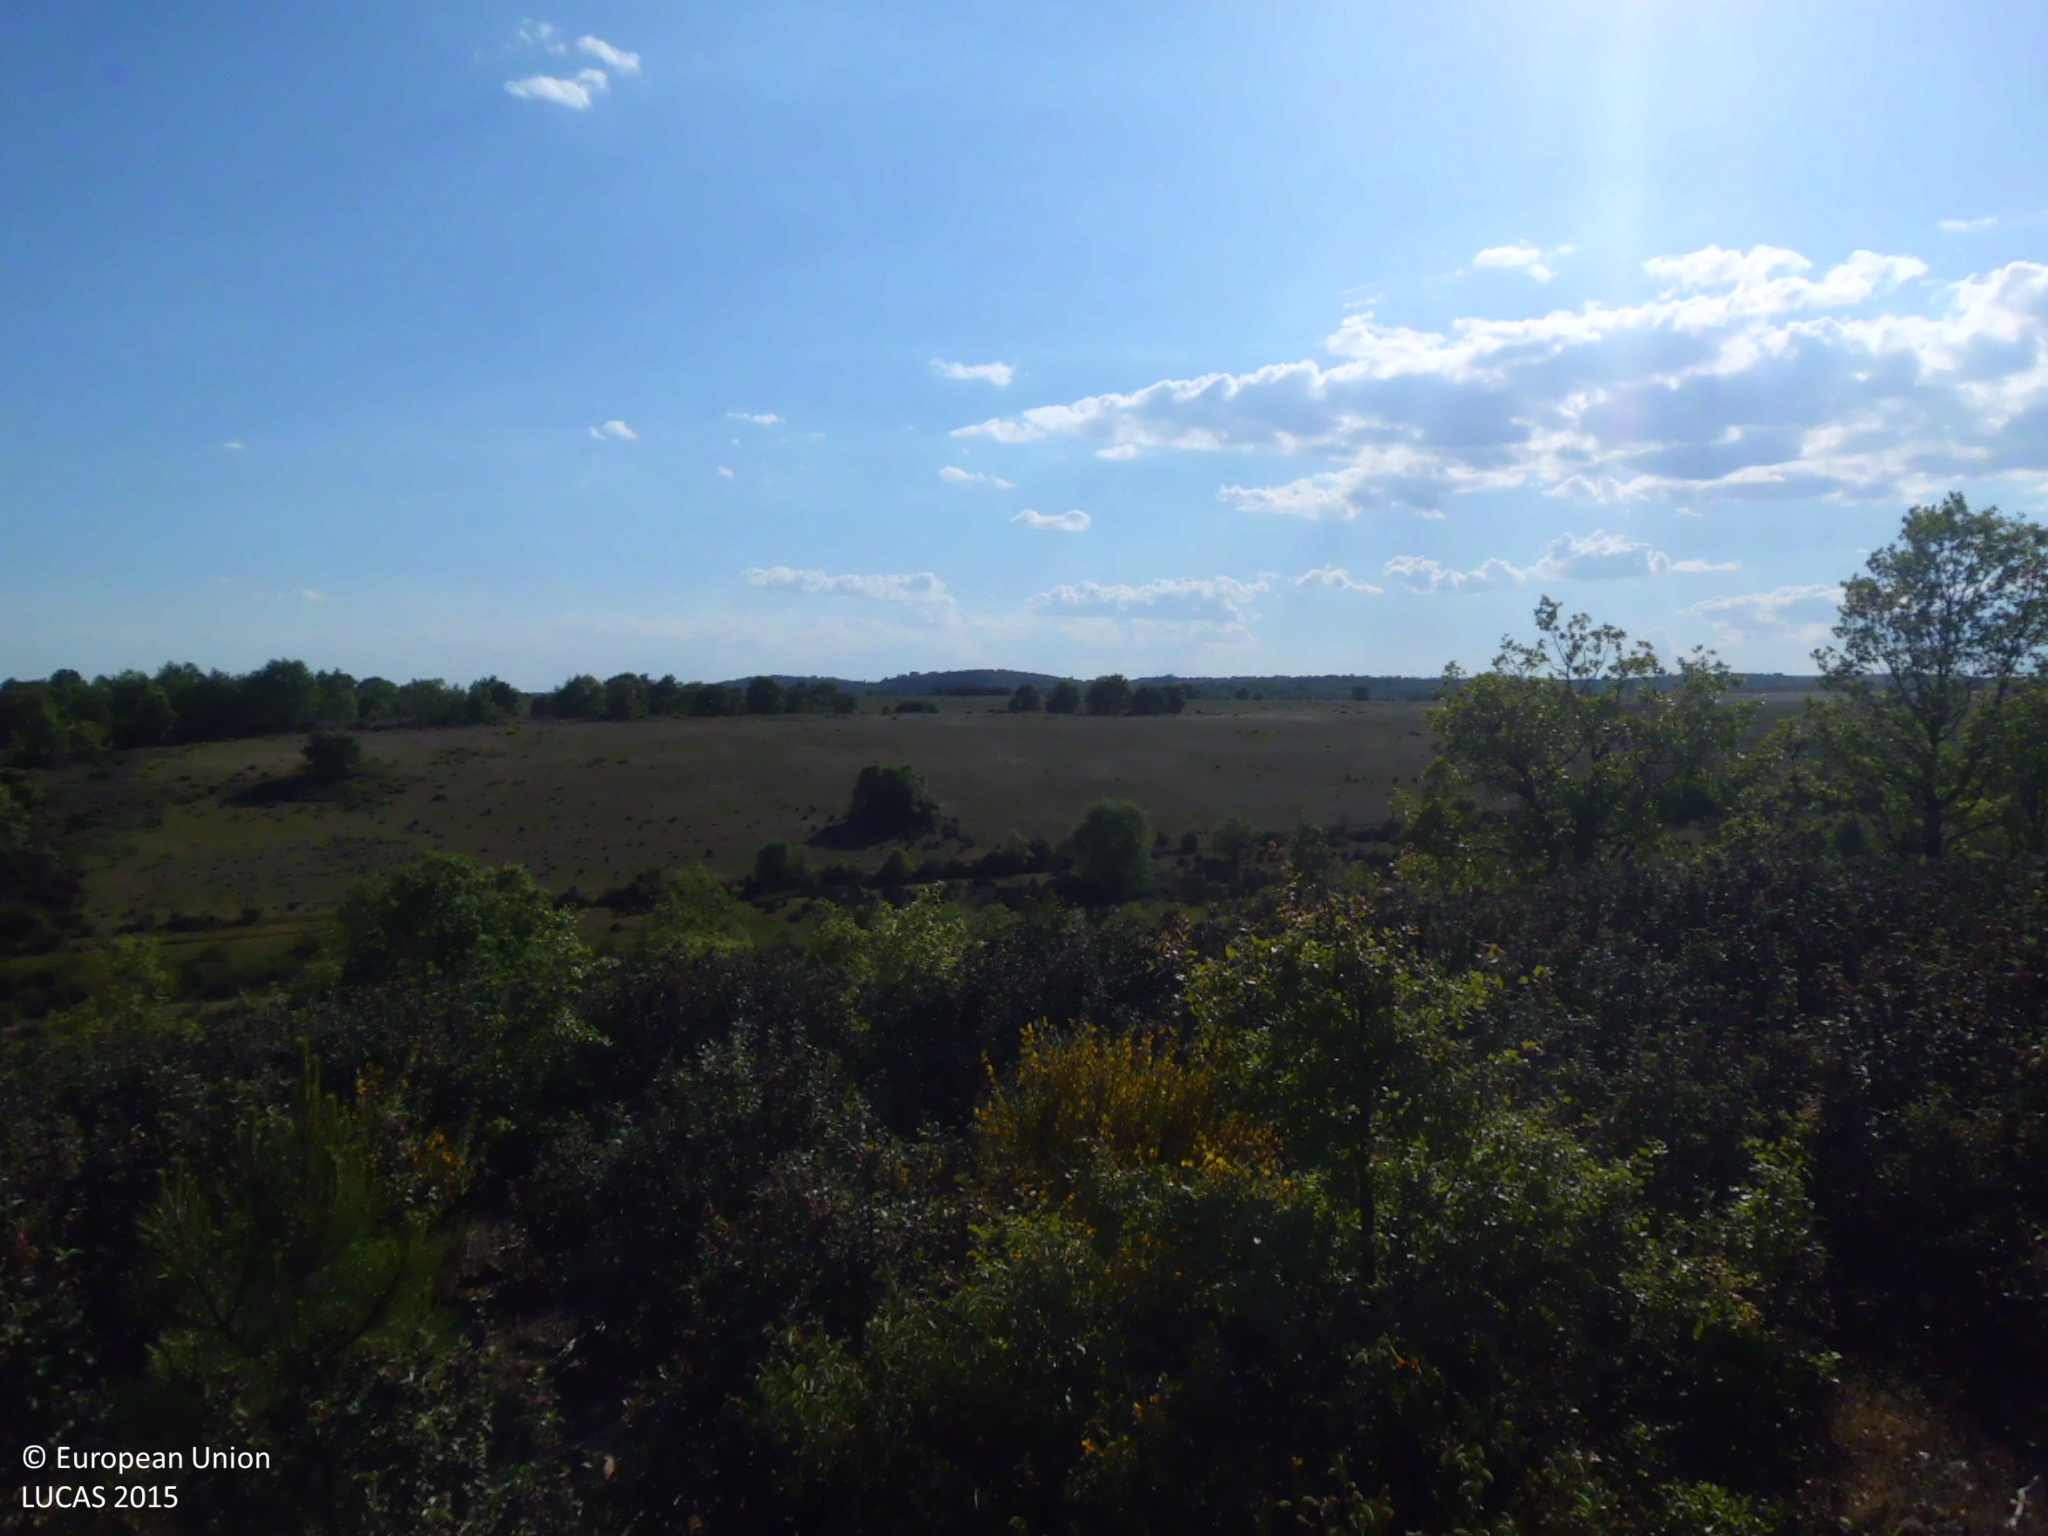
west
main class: Shrubland
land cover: Shrubland with sparse tree cover
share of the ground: 50 - 75 %
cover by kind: shrubs 55 %, herbaceous plants 20 %, unconsolidated bare surface 20 %, coniferous forest trees 5 %
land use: Forestry
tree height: < 5 m
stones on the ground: > 50 %
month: May
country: ES
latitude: 42.6740
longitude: -5.4337
